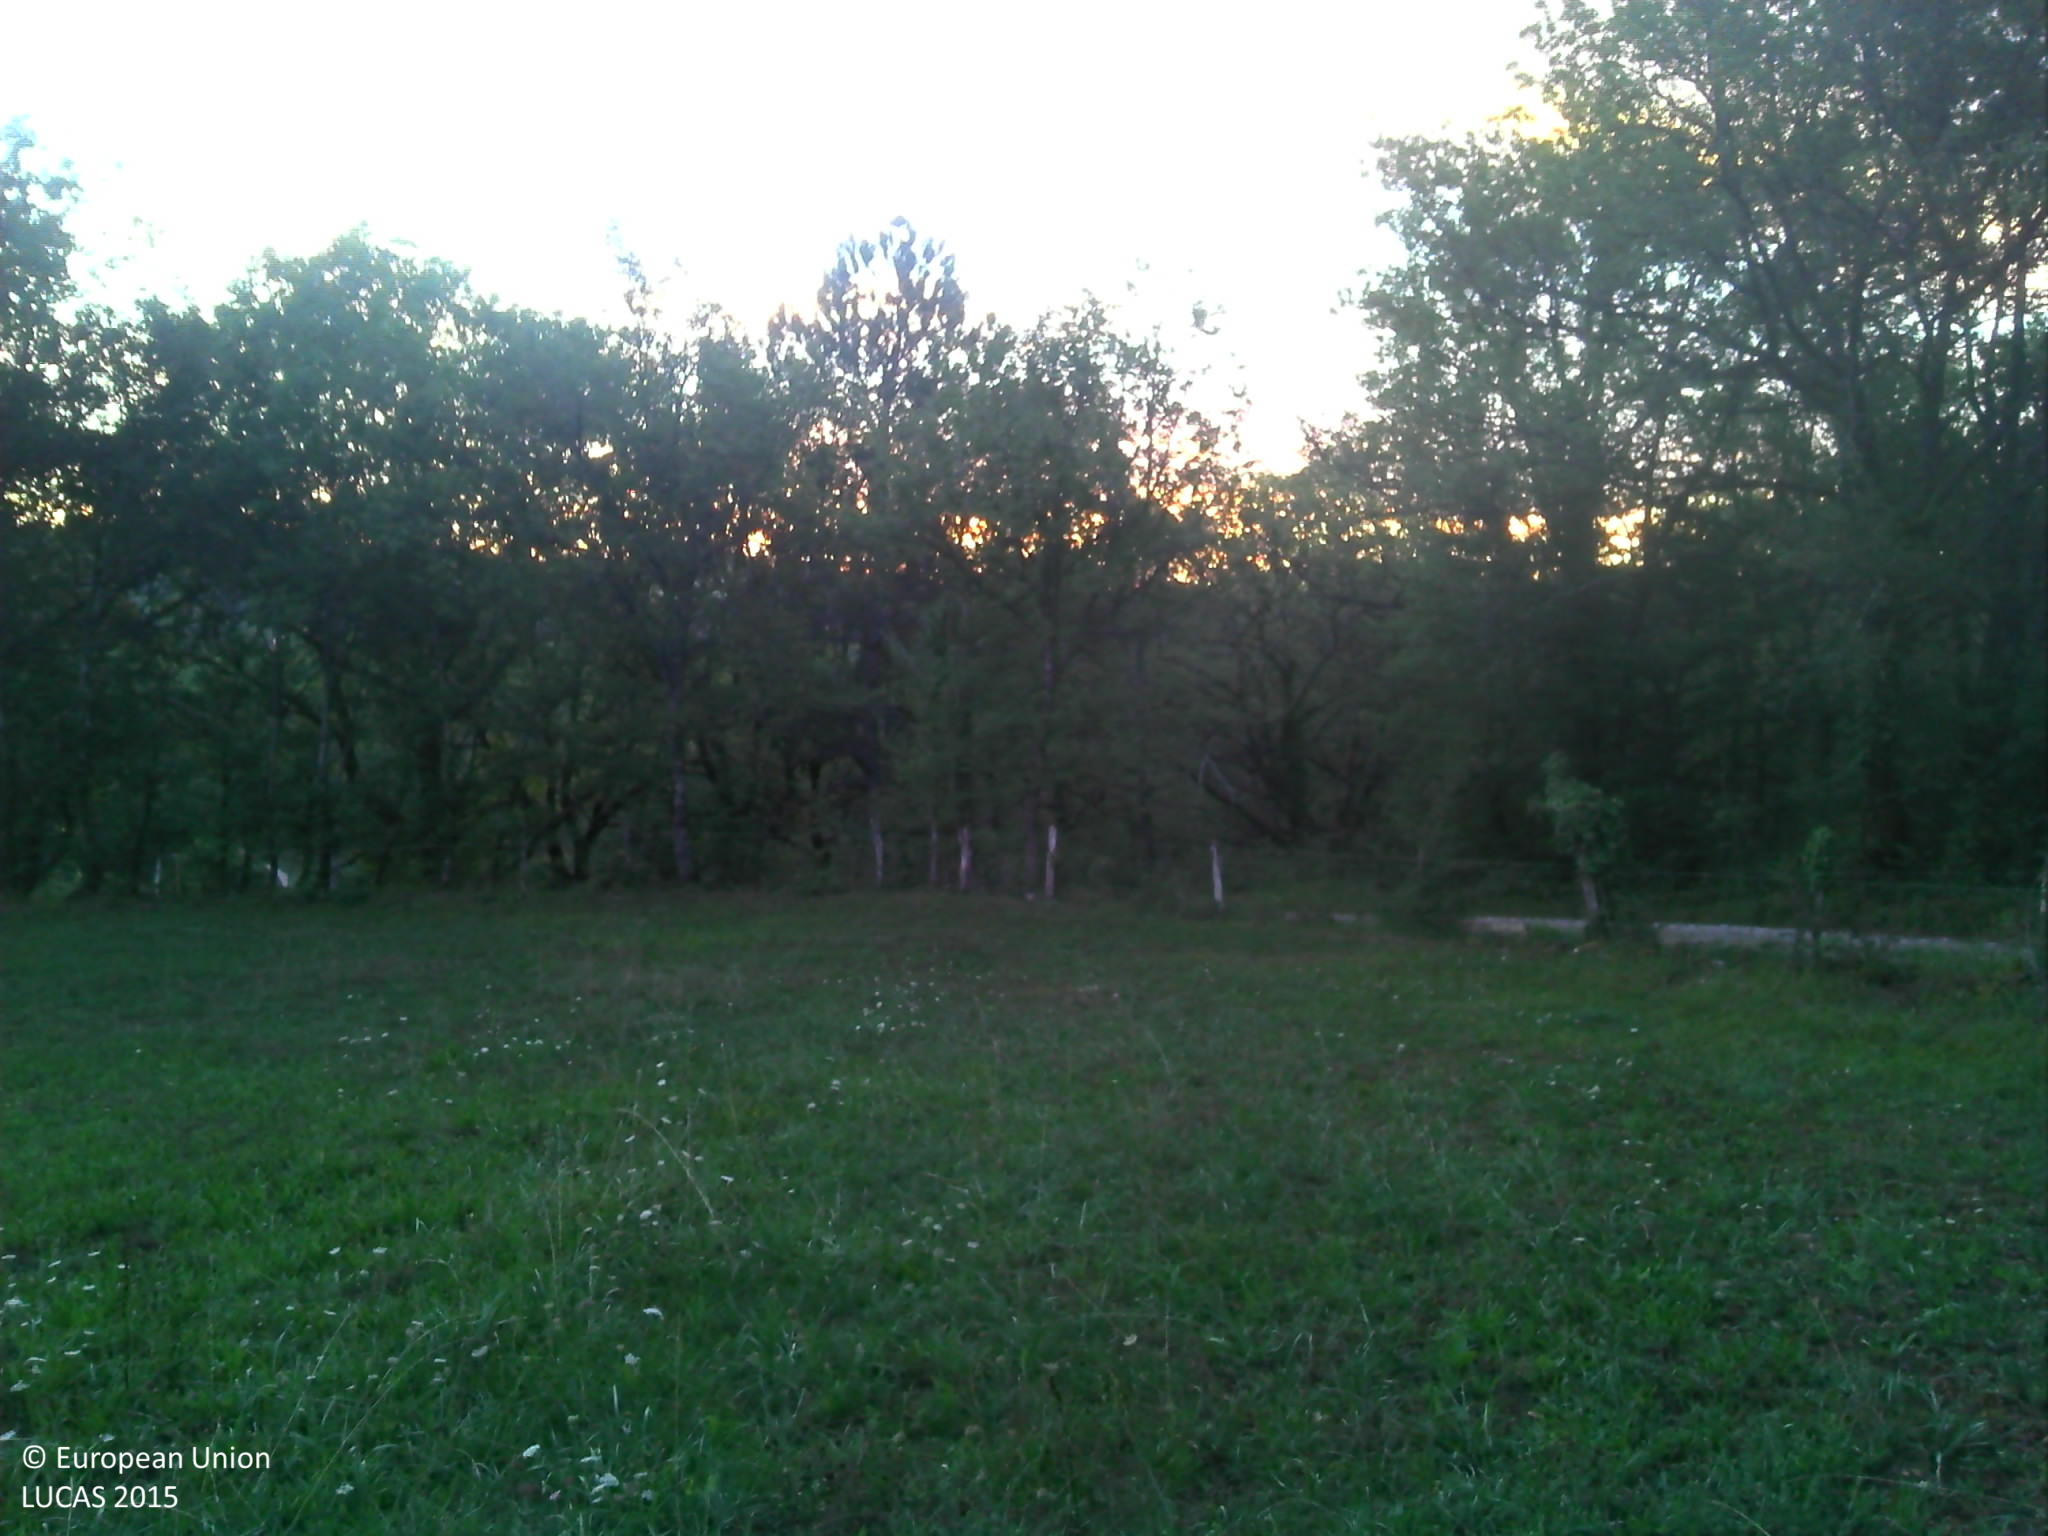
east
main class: Grassland
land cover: Grassland without tree/shrub cover
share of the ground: > 75 %
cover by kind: herbaceous plants 100 %
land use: Agriculture (excluding fallow land and kitchen gardens)
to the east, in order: Grassland without tree/shrub cover; Fences; Grass margins; Tracks; Grass margins; Broadleaved woodland; Fences; Broadleaved woodland; Grassland without tree/shrub cover; Fences; Broadleaved woodland; Tracks; Broadleaved woodland
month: August
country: FR
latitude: 44.8137
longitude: 1.4611
